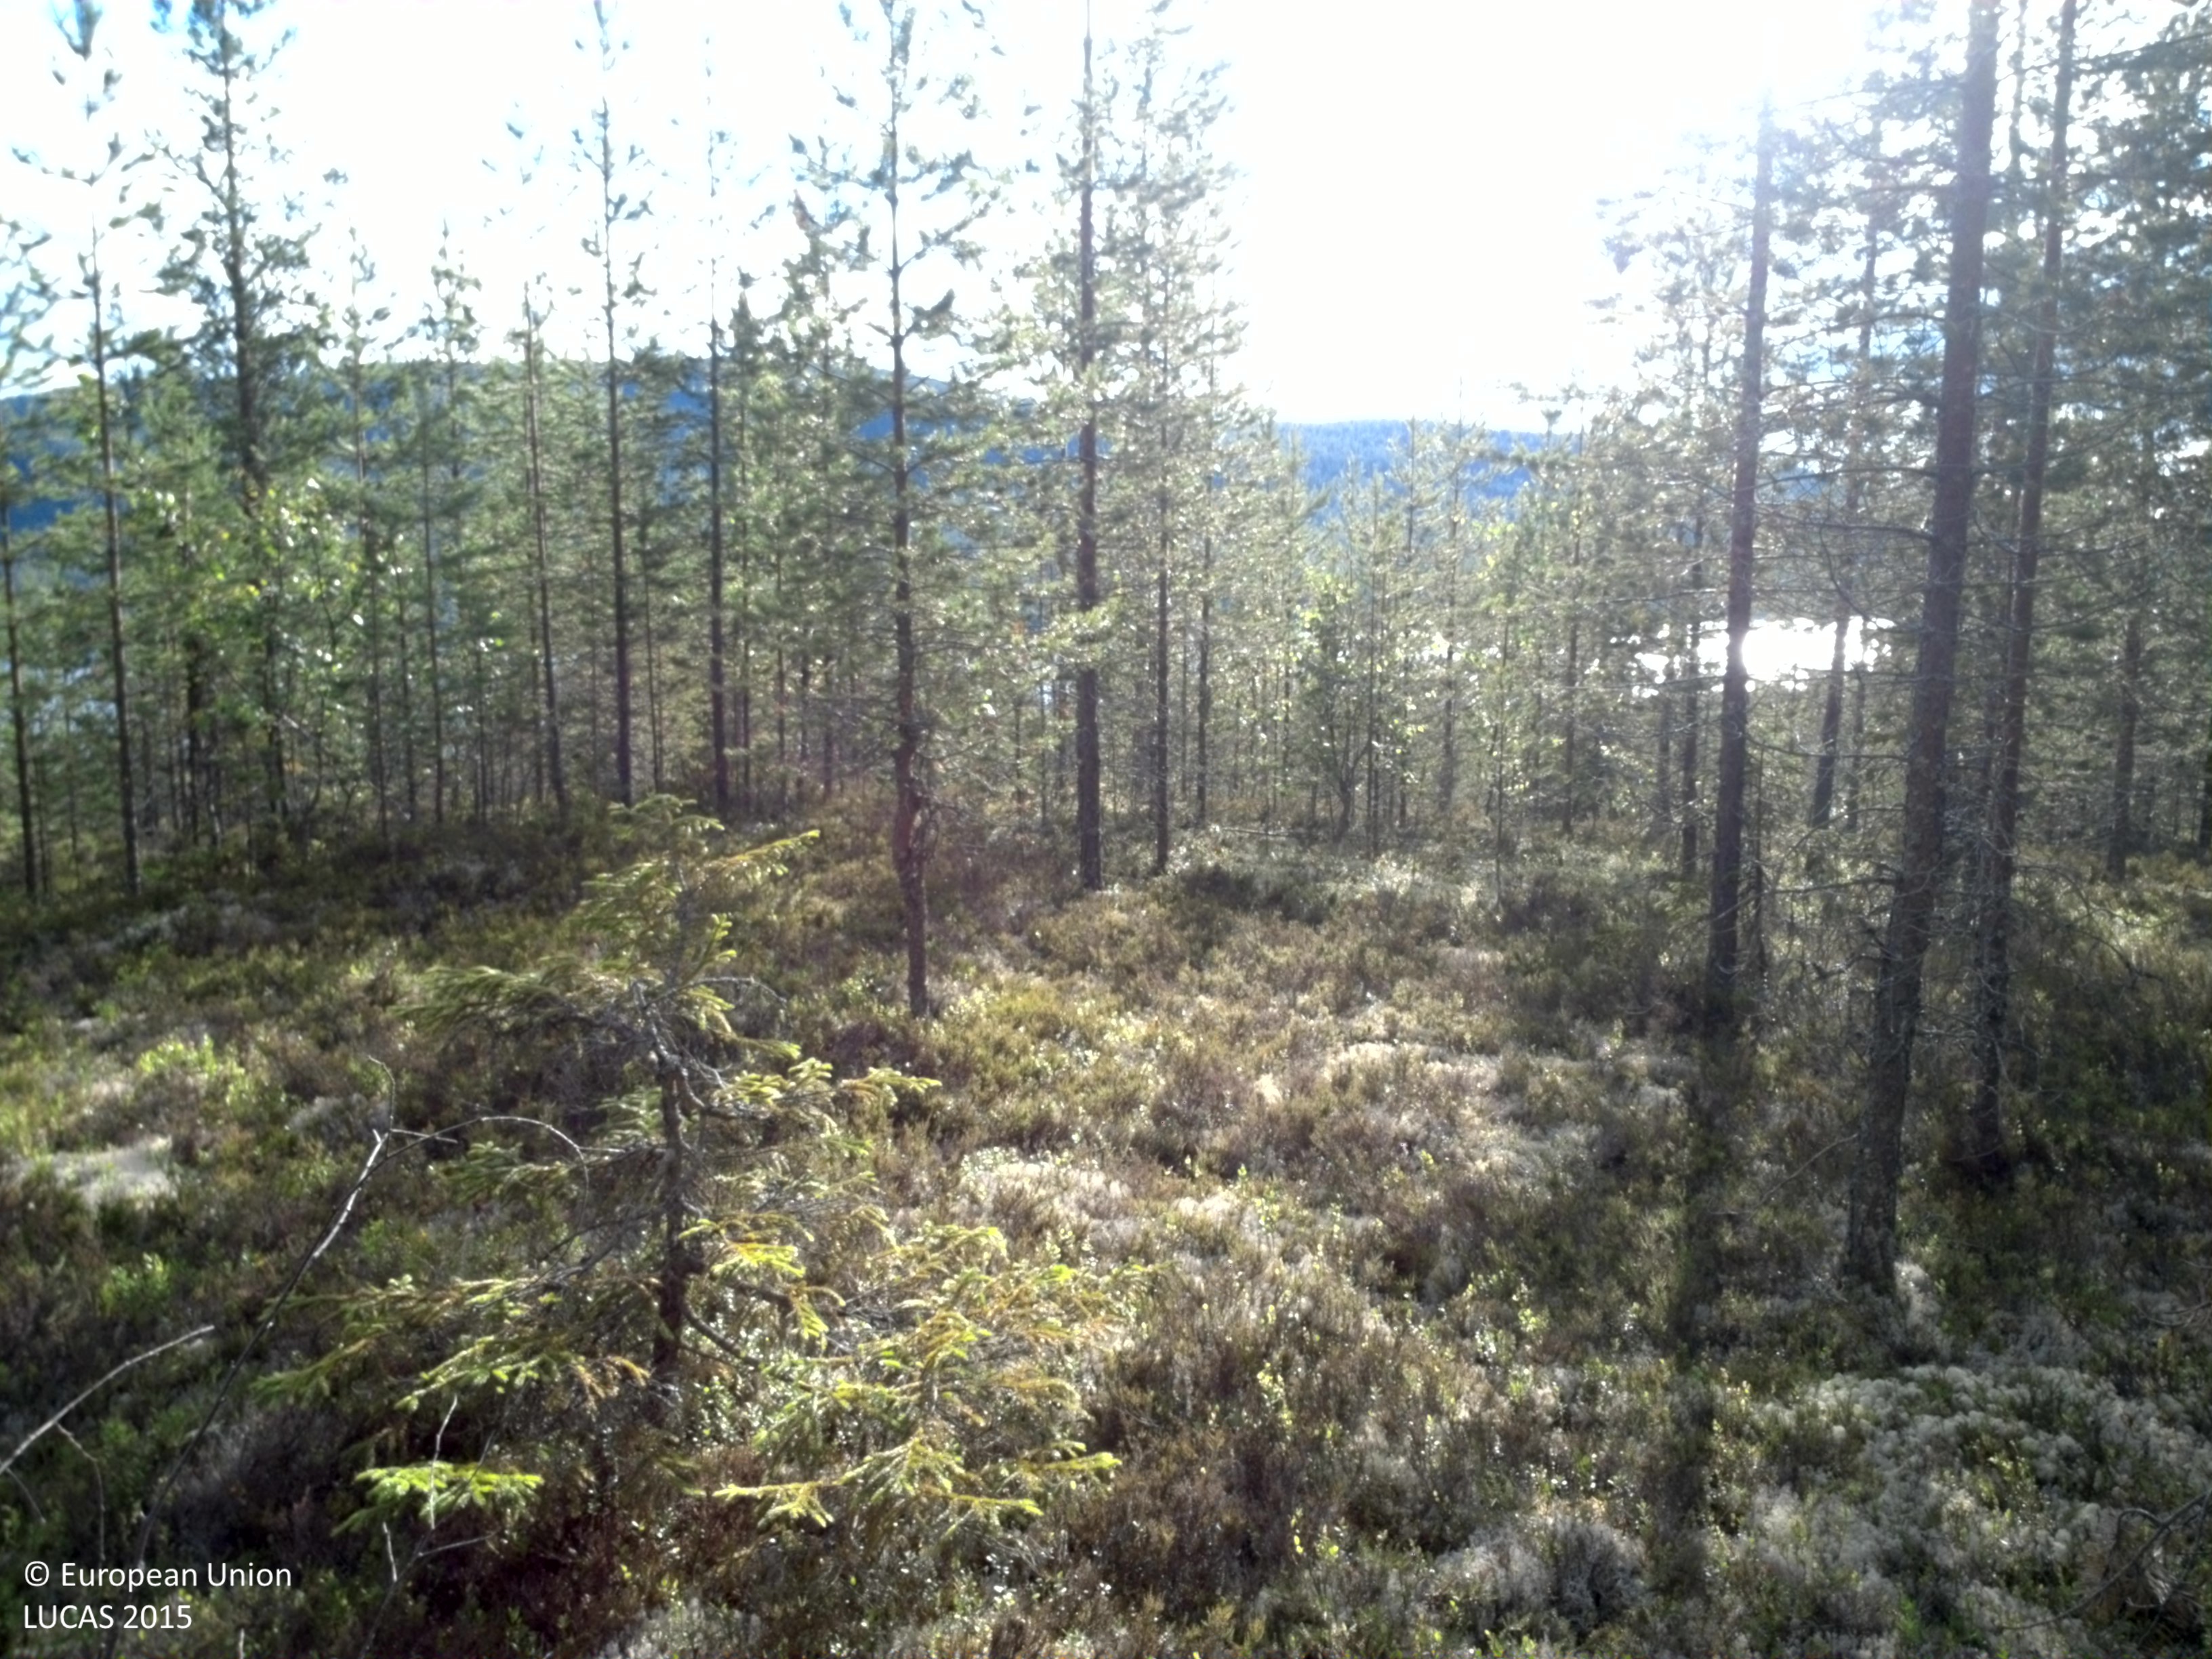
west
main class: Woodland
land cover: Pine dominated coniferous woodland
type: boreal forest
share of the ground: 50 - 75 %
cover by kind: coniferous forest trees 60 %, shrubs 15 %, lichens and mosses 15 %, broadleaved forest trees 10 %
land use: Forestry
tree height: > 5 m
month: July
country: SE
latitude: 61.4847
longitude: 13.6860
